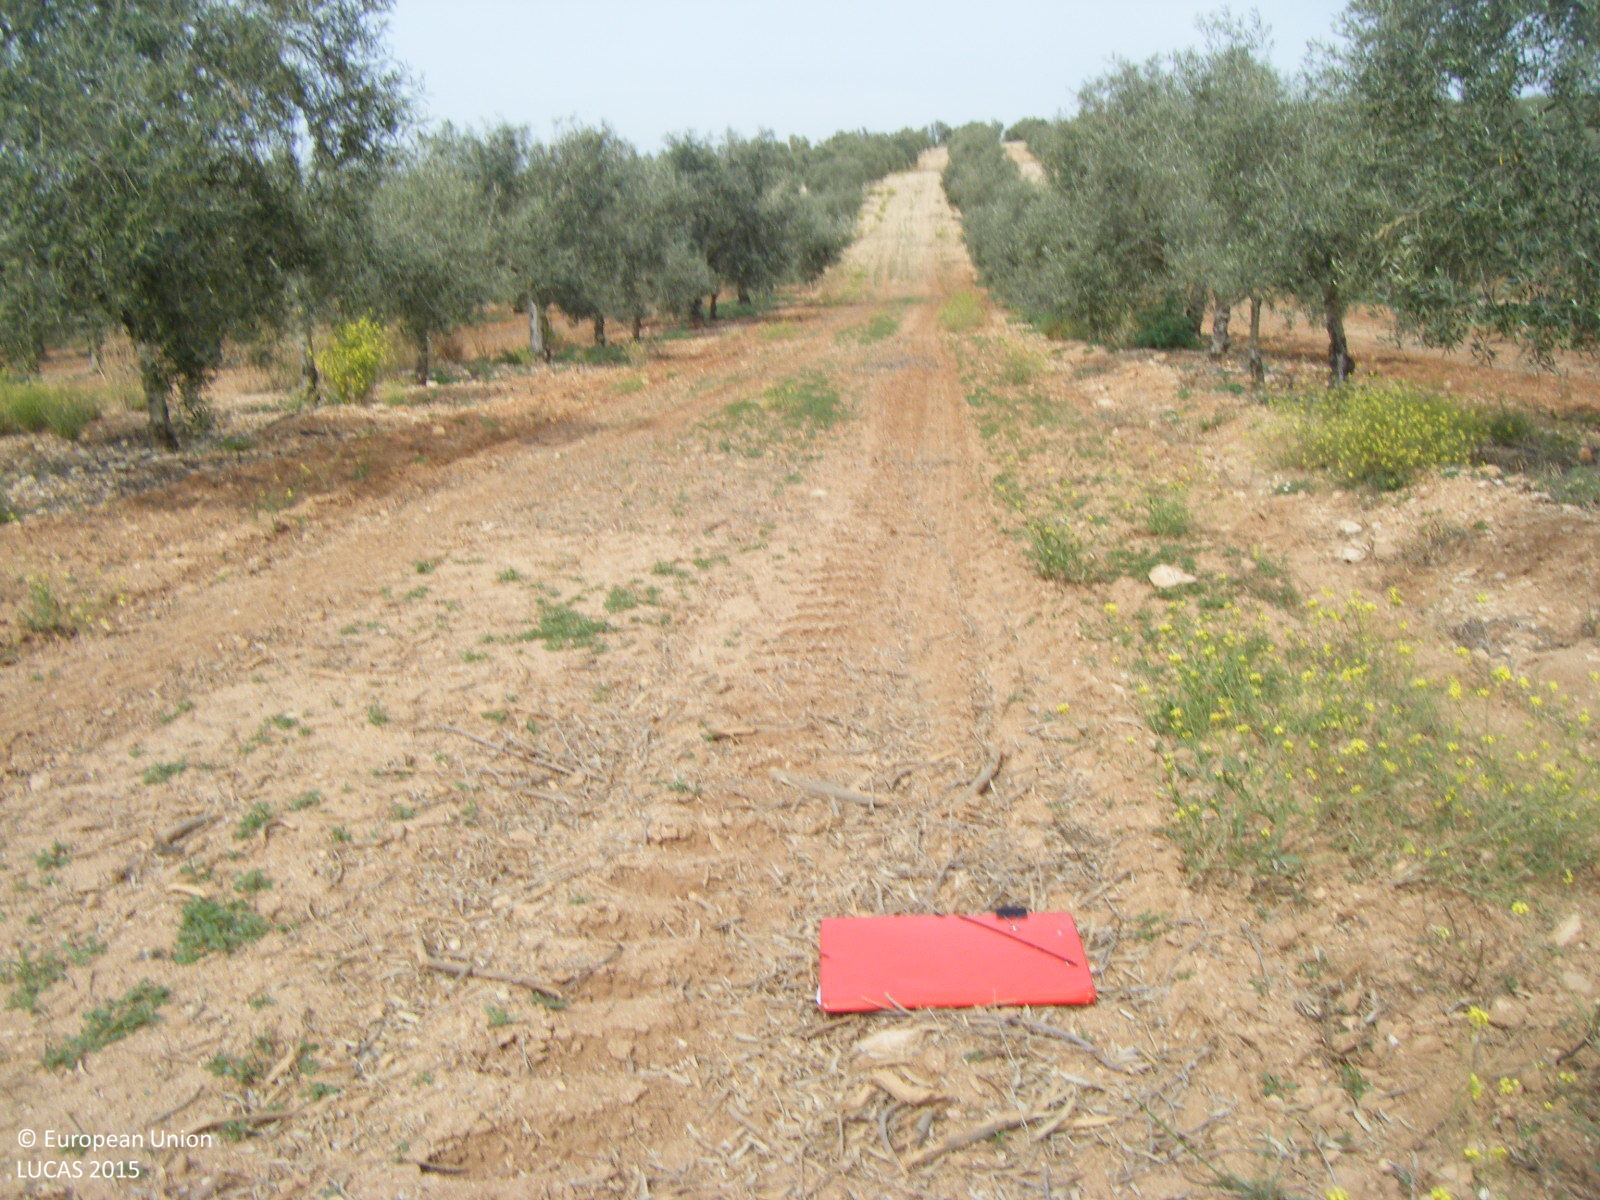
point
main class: Cropland
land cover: Olive groves
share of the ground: 10 - 25 %
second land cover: Other bare soil
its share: > 75 %
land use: Agriculture (excluding fallow land and kitchen gardens)
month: April
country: ES
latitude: 37.0696
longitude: -4.7450
